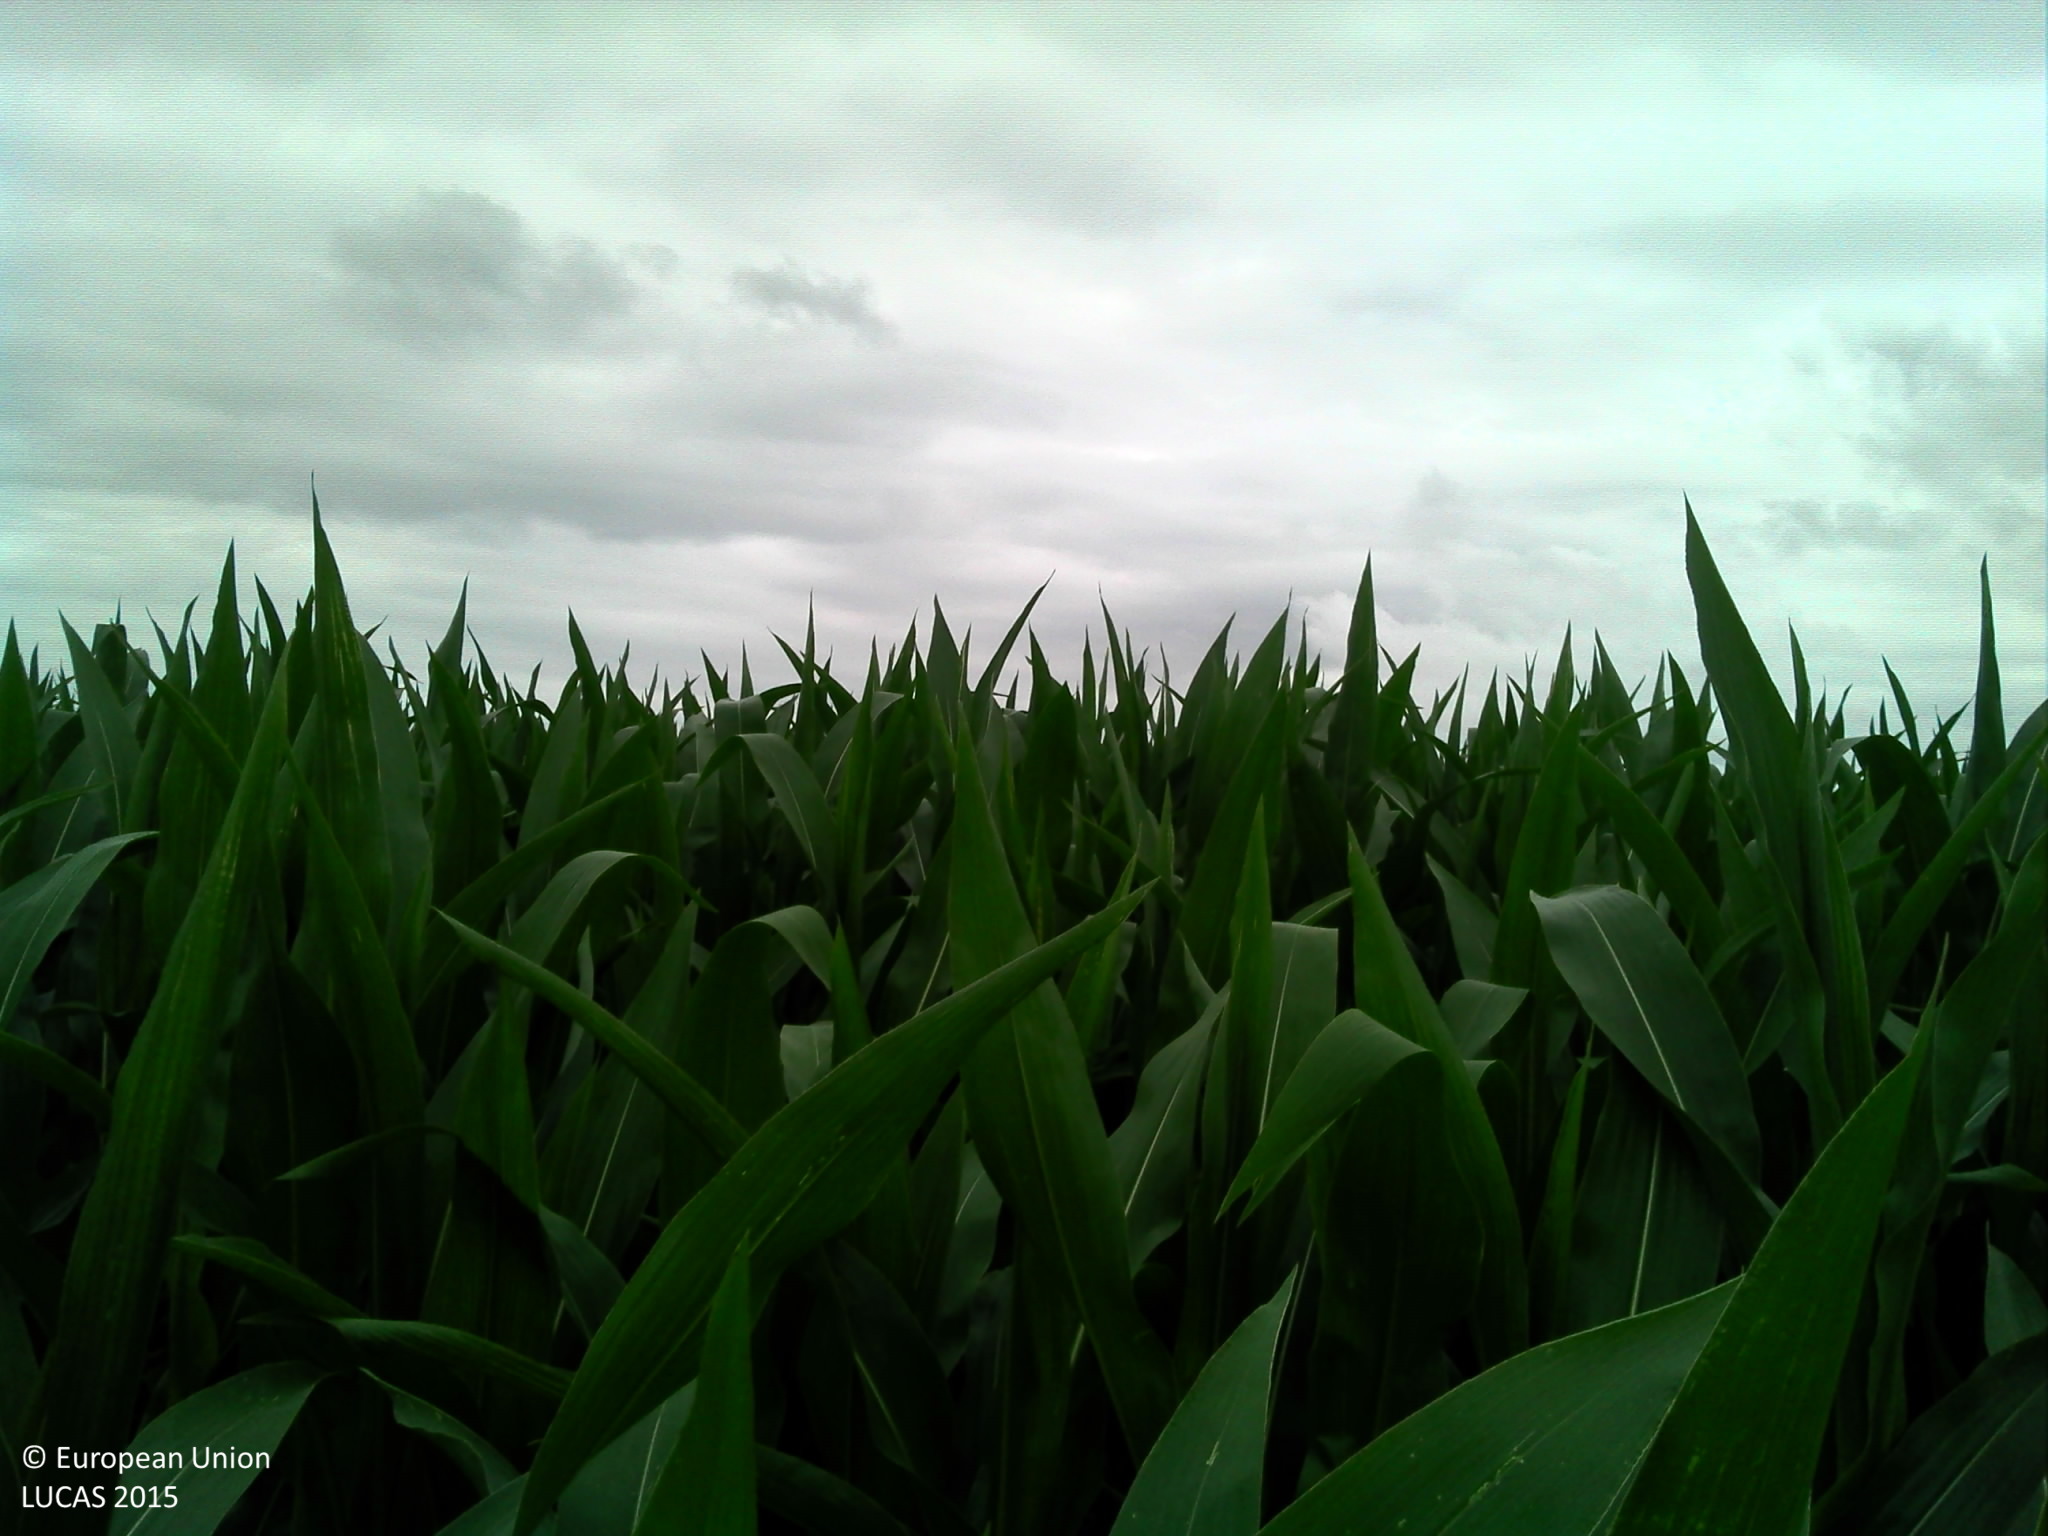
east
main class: Cropland
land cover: Maize
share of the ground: > 75 %
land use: Agriculture (excluding fallow land and kitchen gardens)
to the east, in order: Maize; Grass margins; Common wheat; Maize; Common wheat; Abandoned hedges; Maize
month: July
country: FR
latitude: 48.5987
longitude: -1.8632
